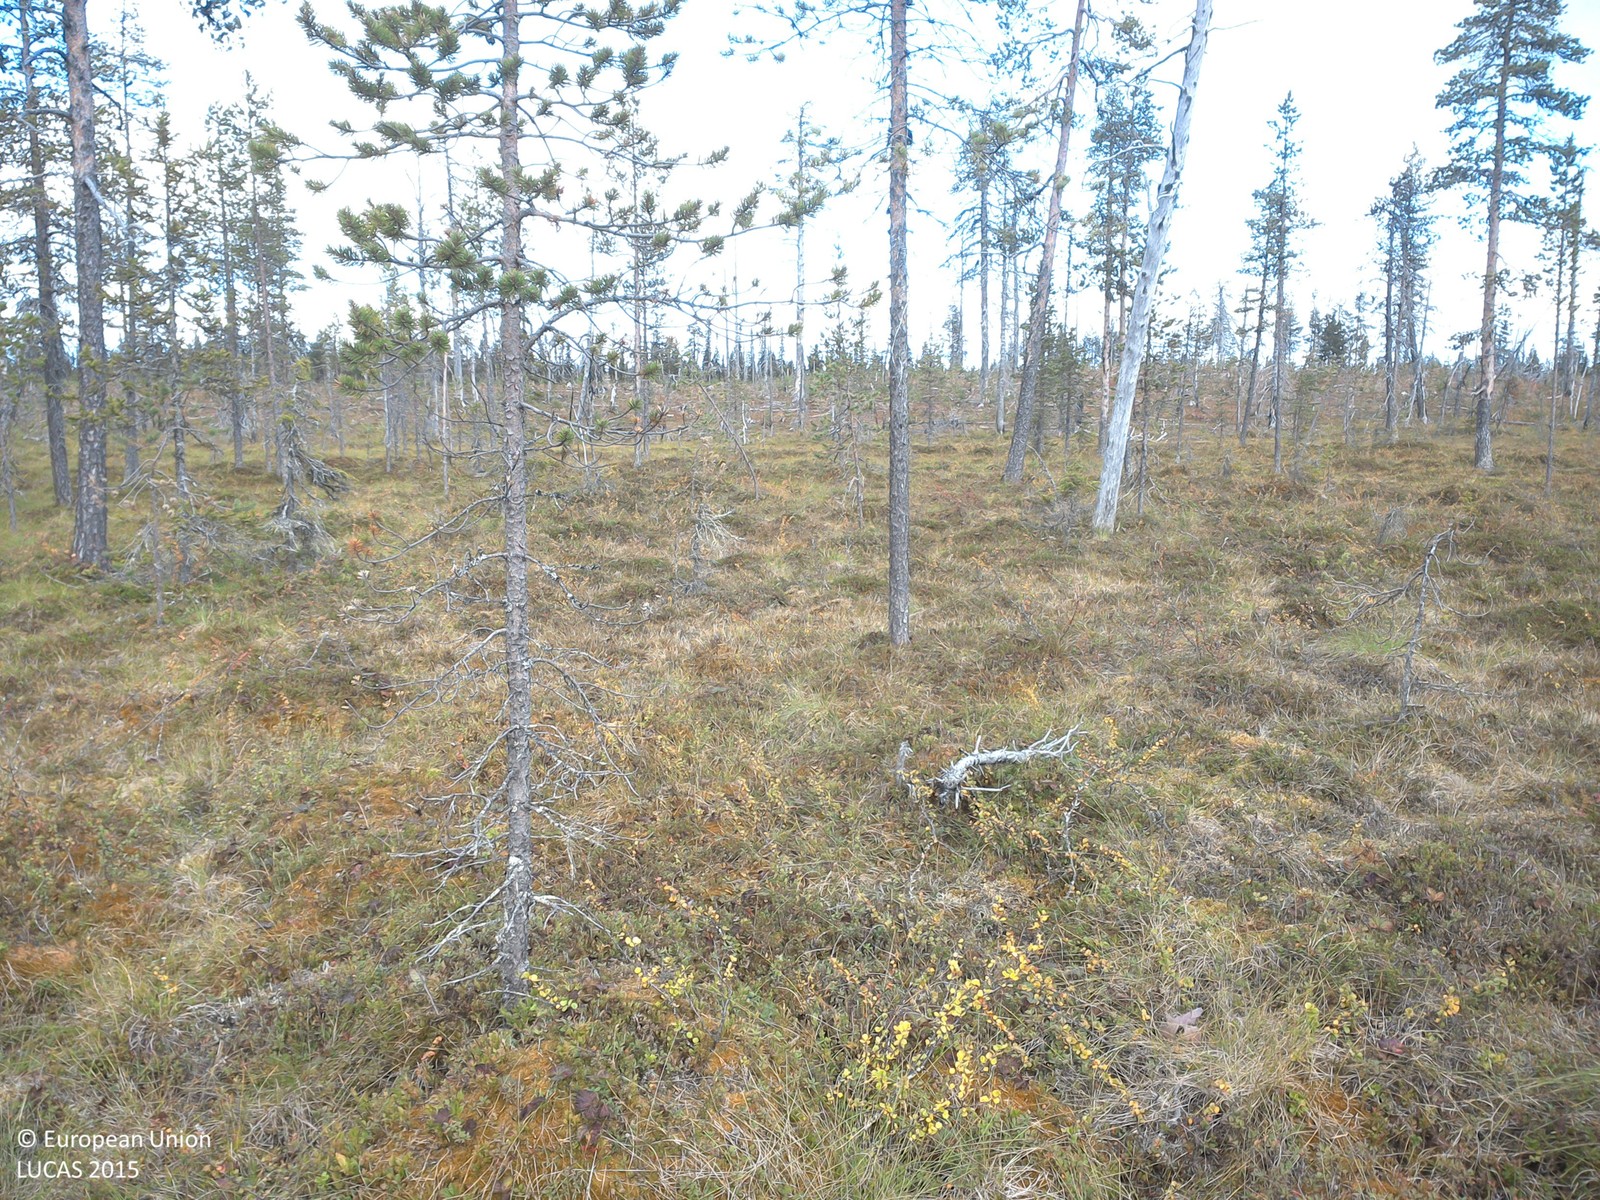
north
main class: Woodland
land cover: Pine dominated coniferous woodland
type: boreal forest
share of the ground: 10 - 25 %
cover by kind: shrubs 60 %, coniferous forest trees 15 %, lichens and mosses 15 %, herbaceous plants 10 %
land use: Forestry
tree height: > 5 m
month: September
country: SE
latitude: 67.8627
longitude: 23.1091
